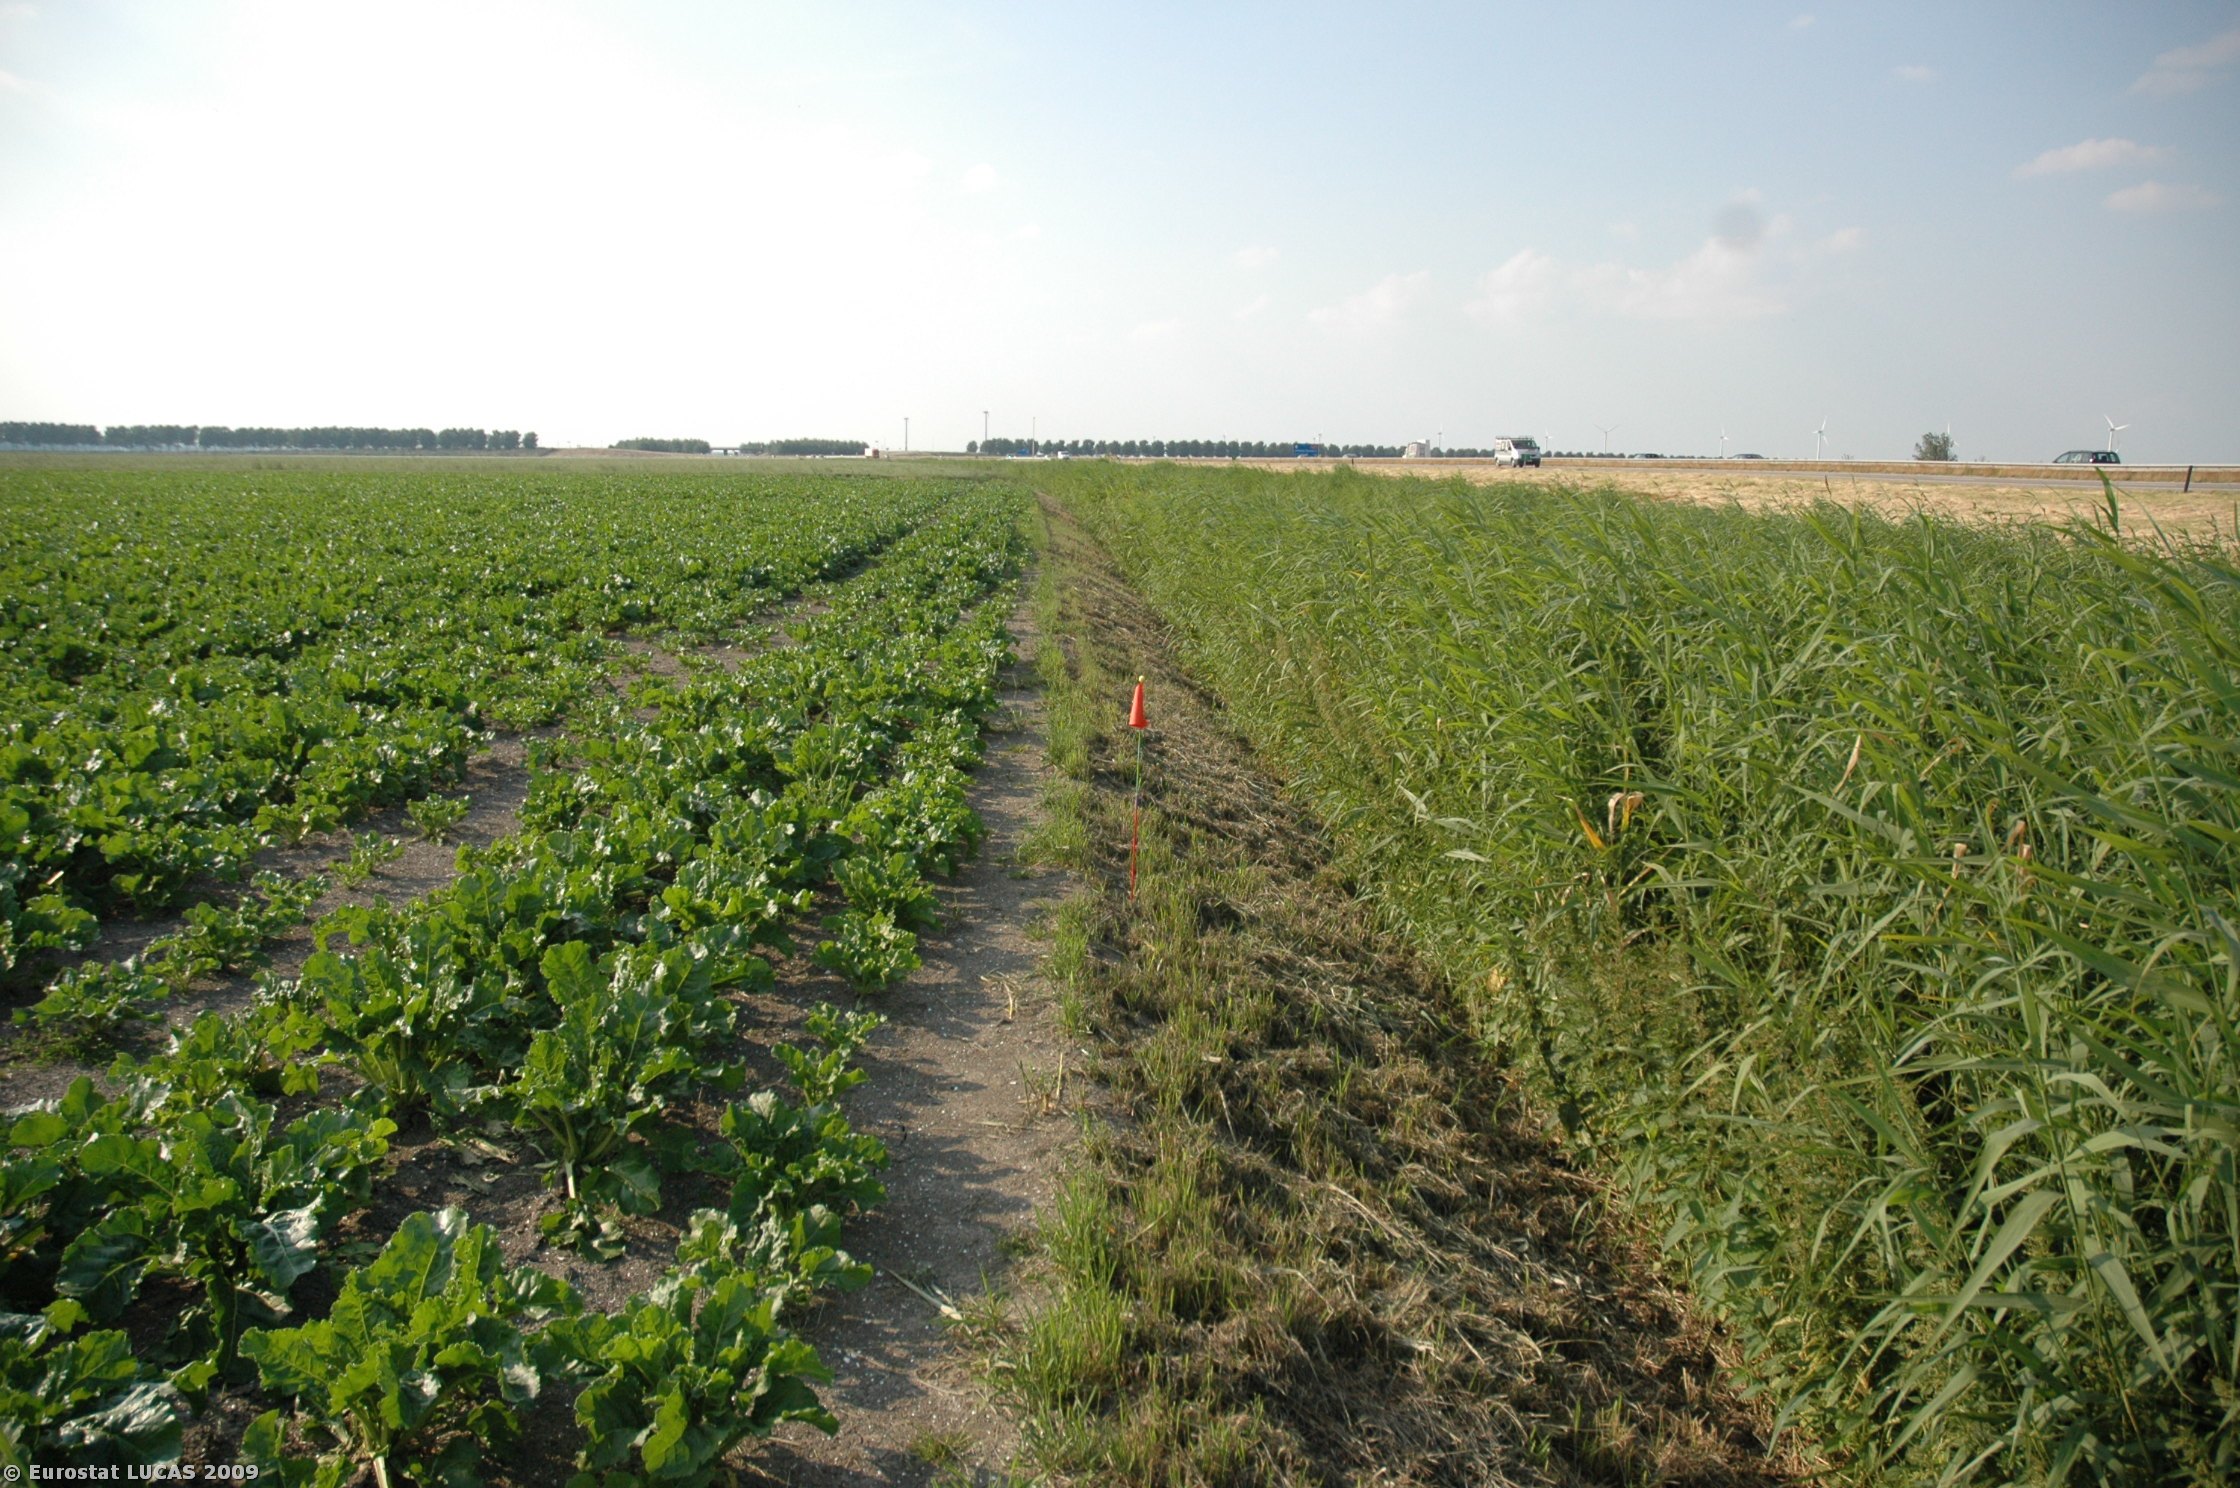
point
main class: Grassland
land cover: Grassland without tree/shrub cover
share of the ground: > 75 %
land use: Agriculture (excluding fallow land and kitchen gardens)
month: June
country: NL
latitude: 52.3403
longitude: 5.3453
